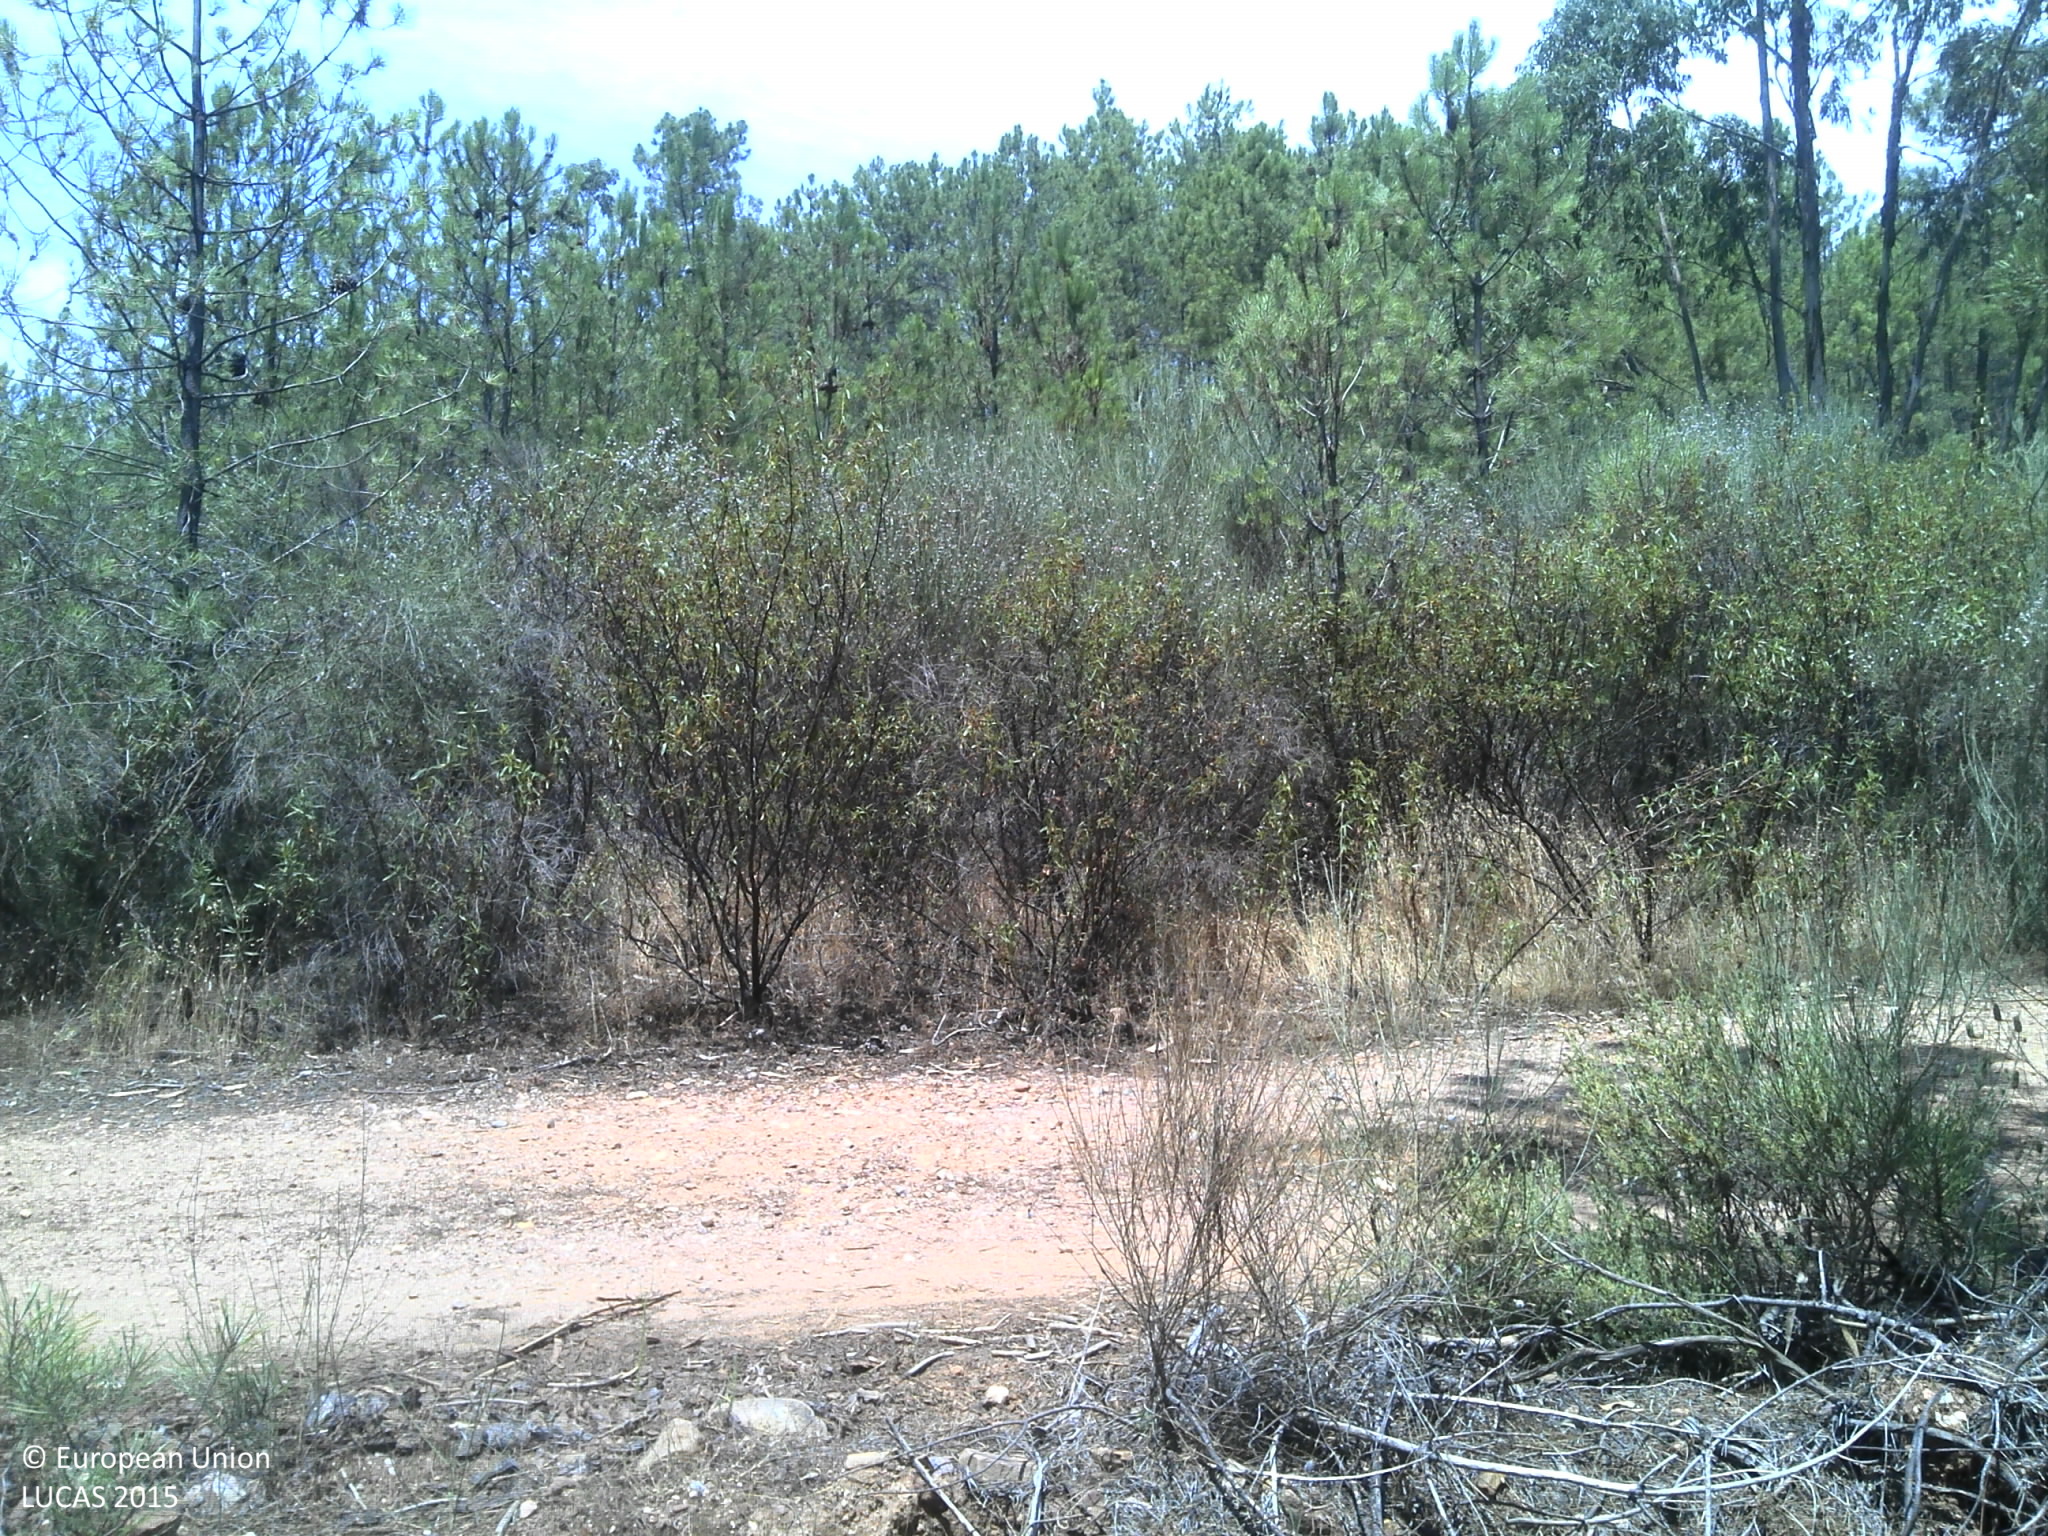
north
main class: Woodland
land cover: Pine dominated coniferous woodland
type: coniferous forest of the mediterranean region
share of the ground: > 75 %
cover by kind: coniferous forest trees 75 %, shrubs 15 %, unconsolidated bare surface 5 %
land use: Forestry
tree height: > 5 m
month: June
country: PT
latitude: 39.9469
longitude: -7.0262
